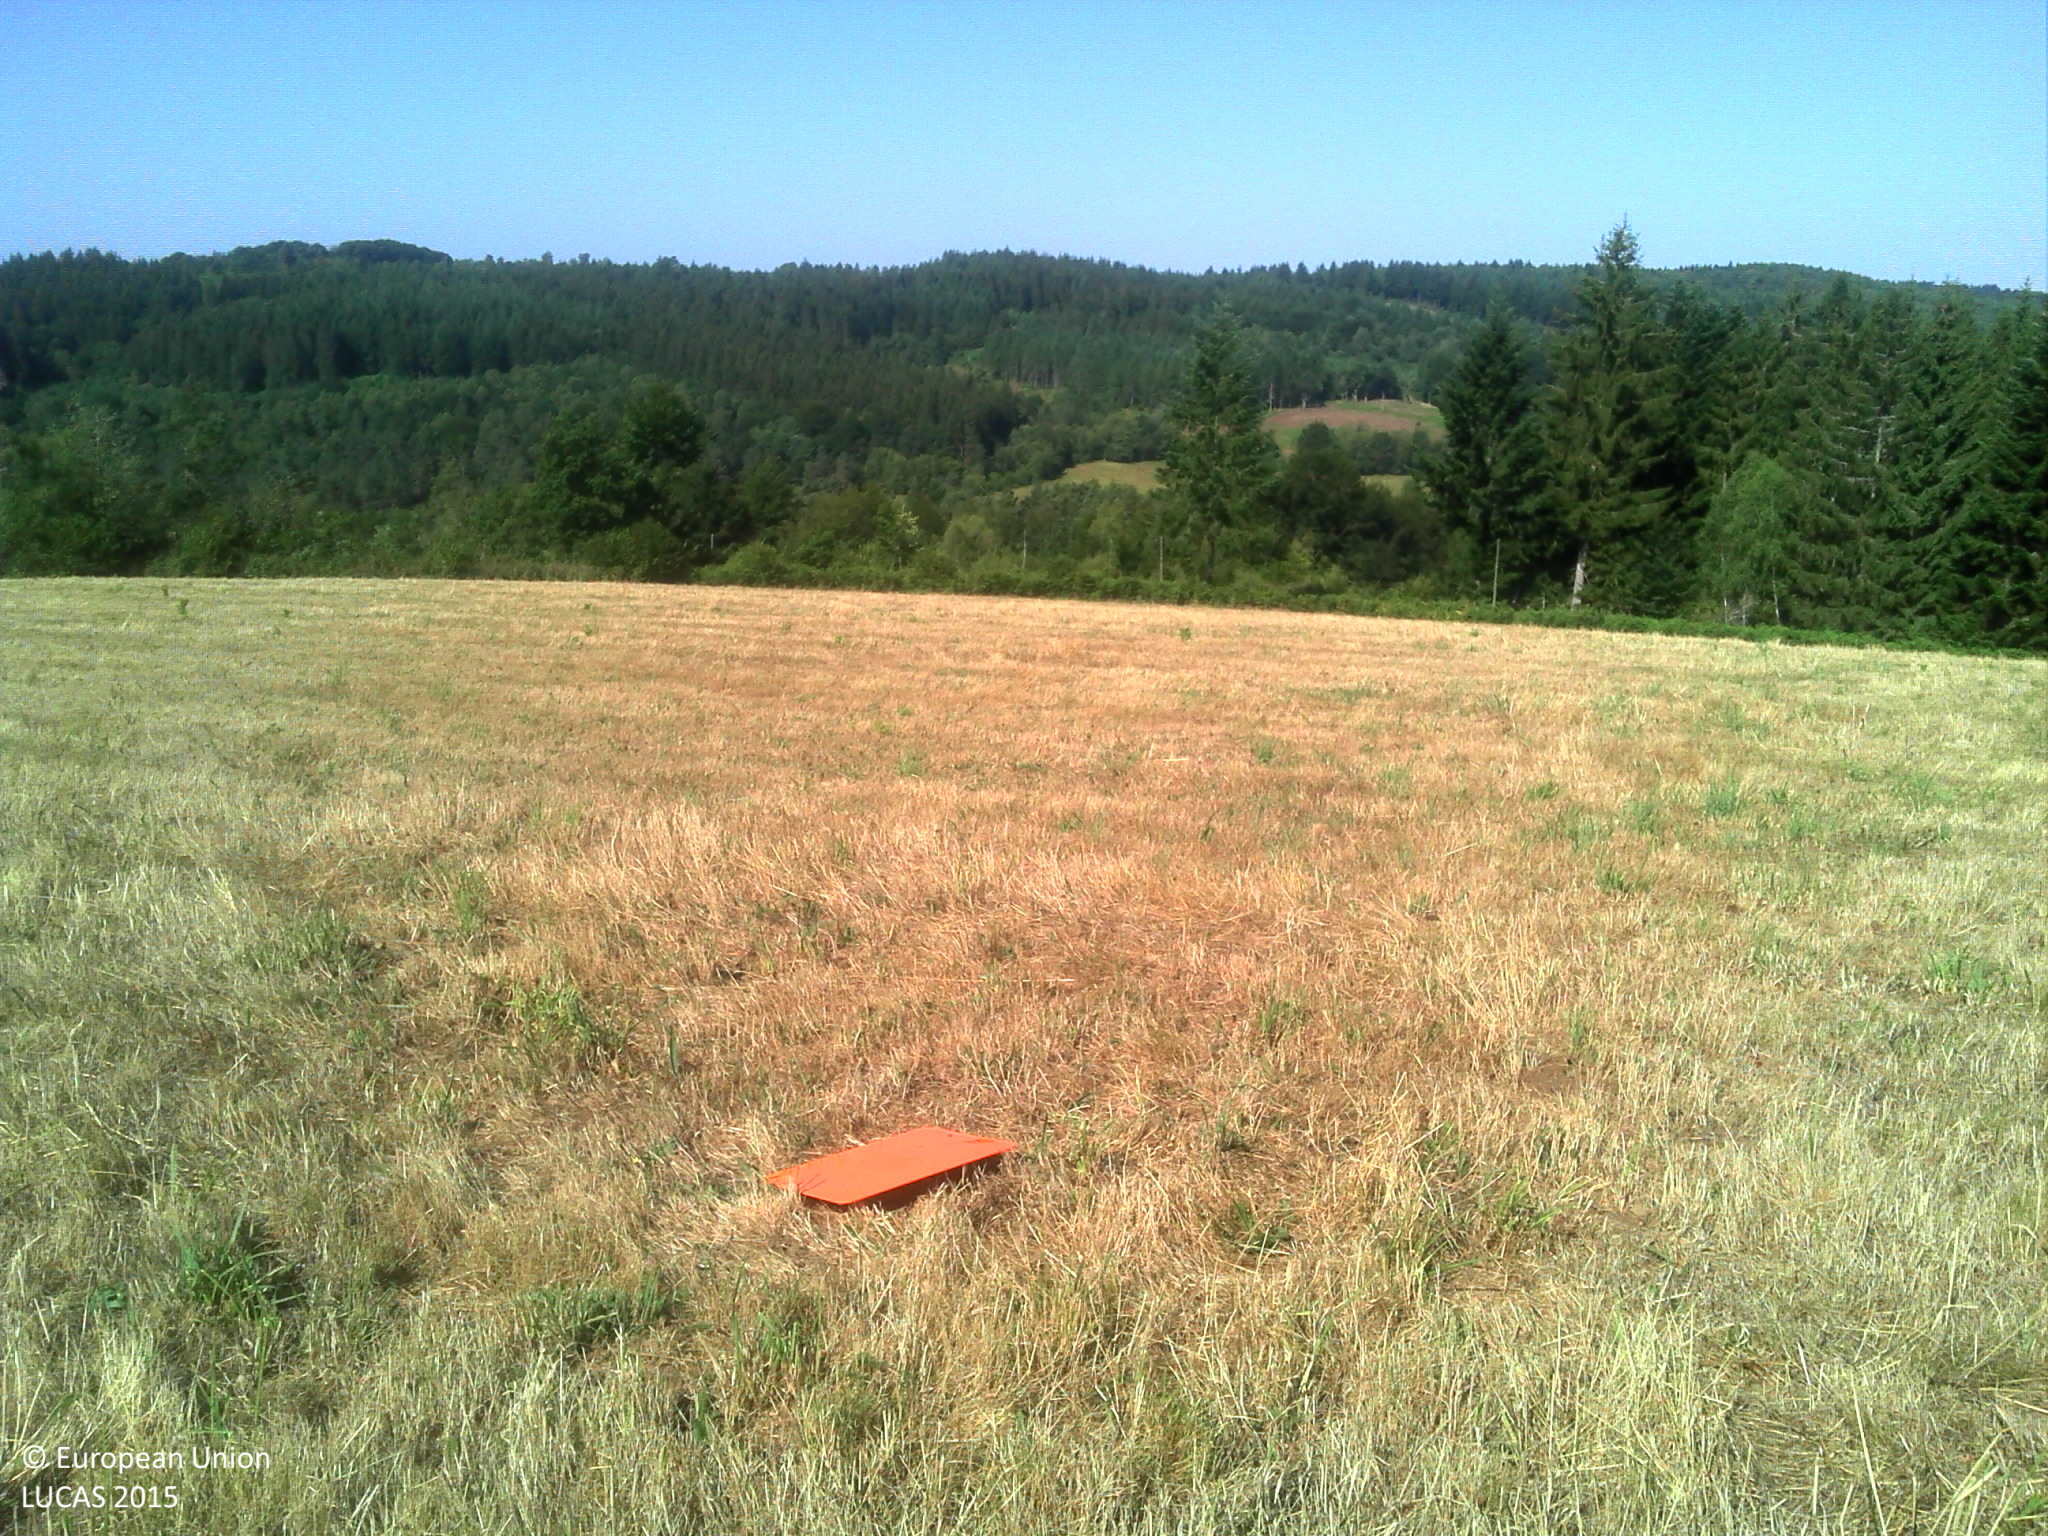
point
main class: Grassland
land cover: Grassland without tree/shrub cover
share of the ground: > 75 %
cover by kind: herbaceous plants 100 %
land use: Agriculture (excluding fallow land and kitchen gardens)
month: August
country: FR
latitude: 45.6777
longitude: 2.3328
